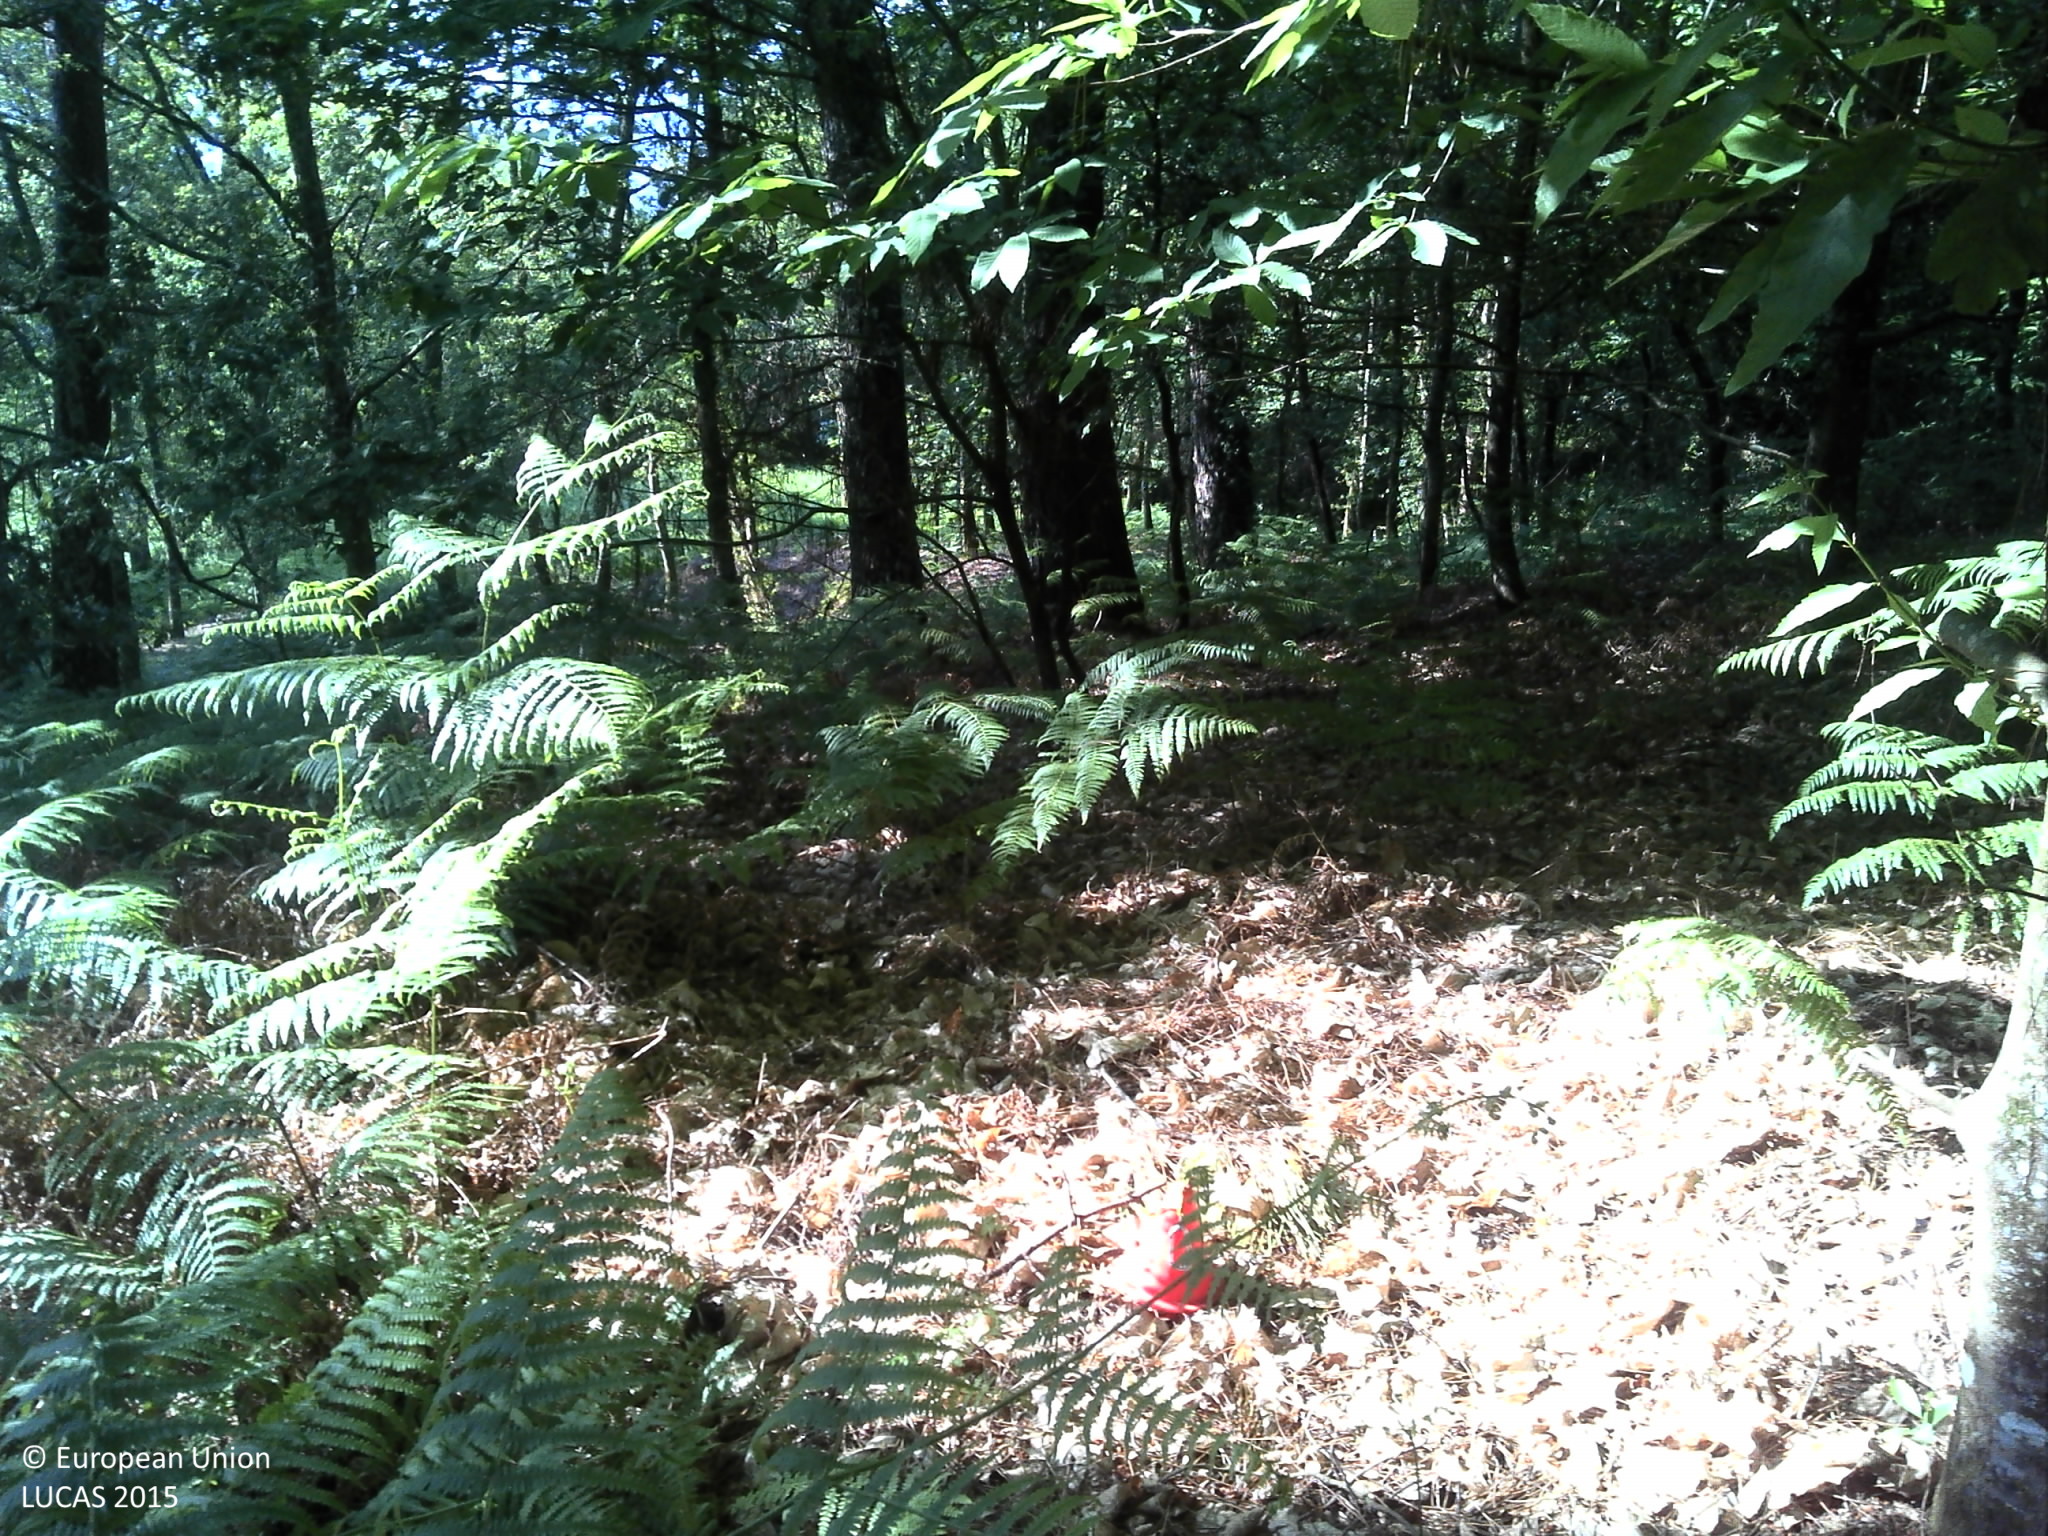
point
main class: Woodland
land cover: Broadleaved woodland
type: acidophilous oak and oak-birch forest
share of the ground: > 75 %
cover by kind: broadleaved forest trees 85 %, coniferous forest trees 5 %, herbaceous plants 5 %, unconsolidated bare surface 5 %
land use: Forestry
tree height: > 5 m
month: June
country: PT
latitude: 42.0864
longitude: -8.2549
